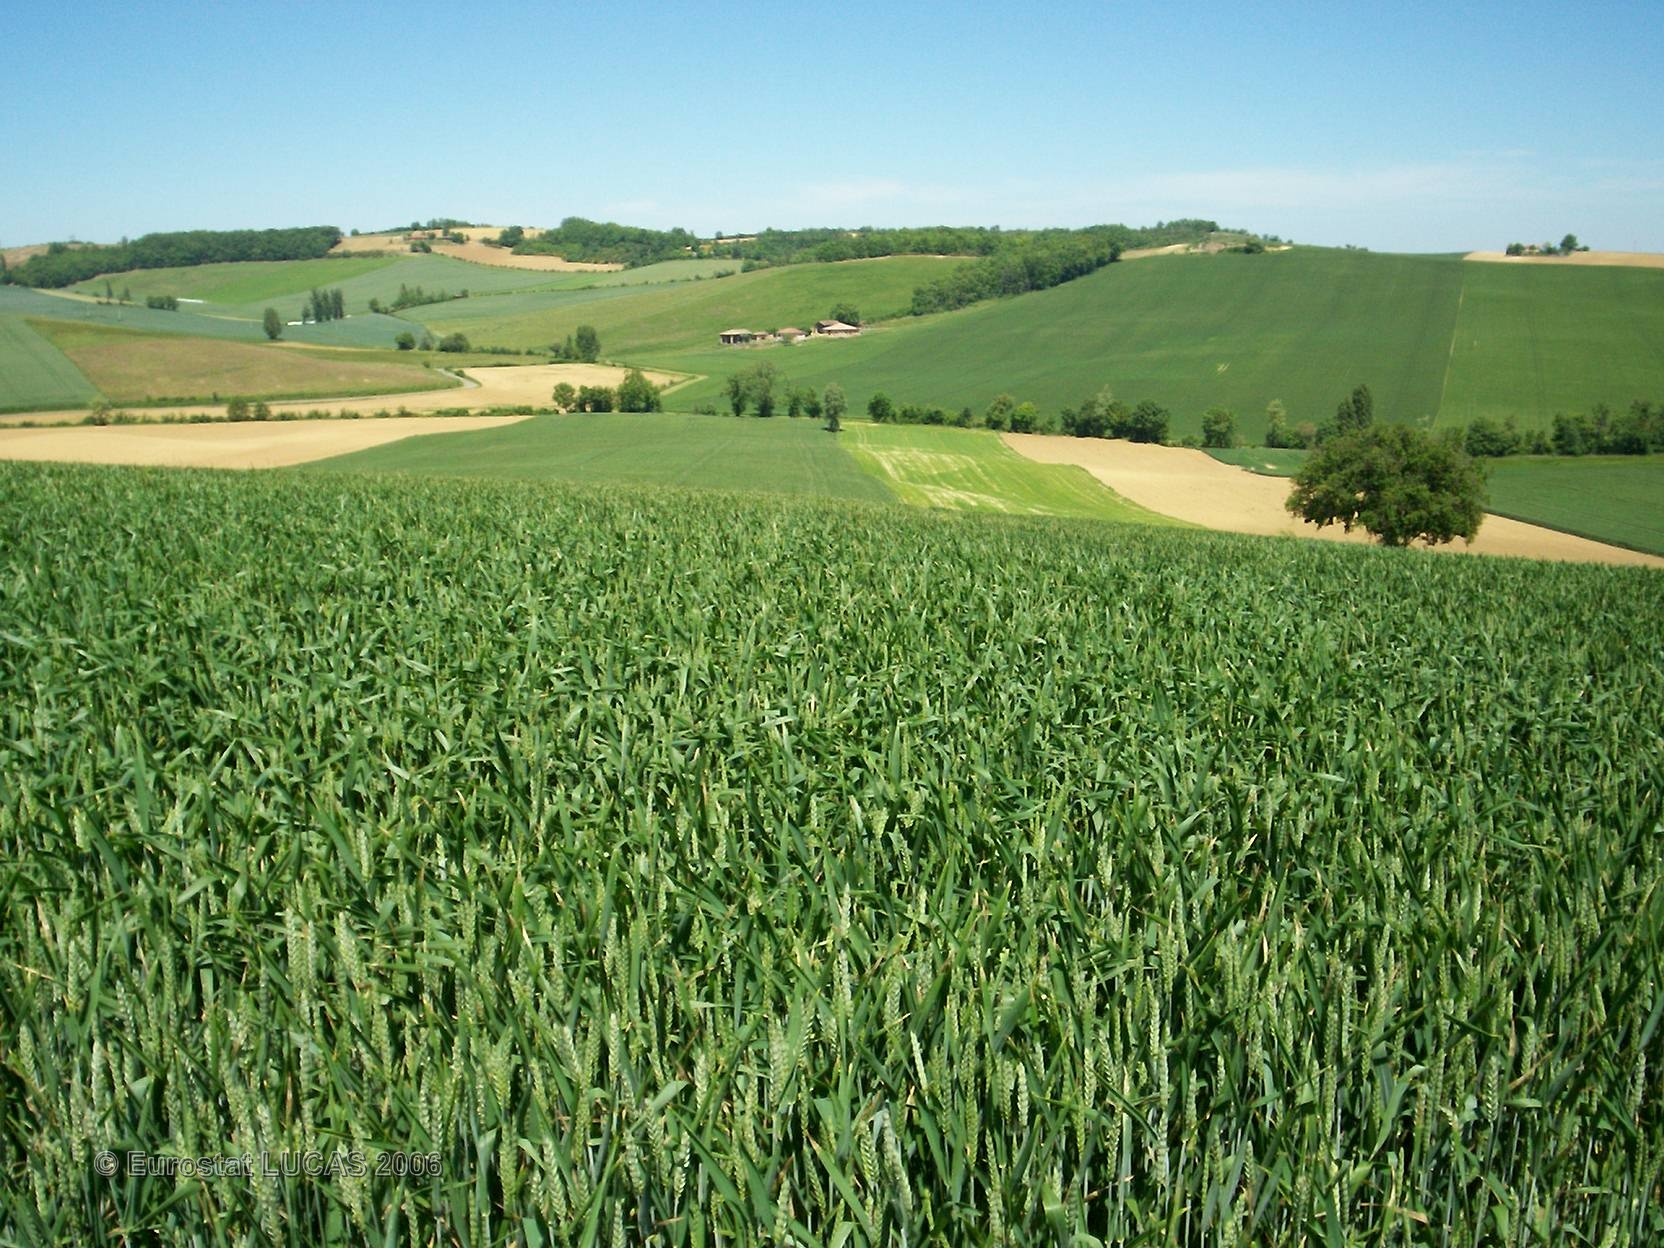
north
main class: Cropland
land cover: Durum wheat
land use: Agriculture (excluding fallow land and kitchen gardens)
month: May
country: FR
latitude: 43.4572
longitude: 0.8674
